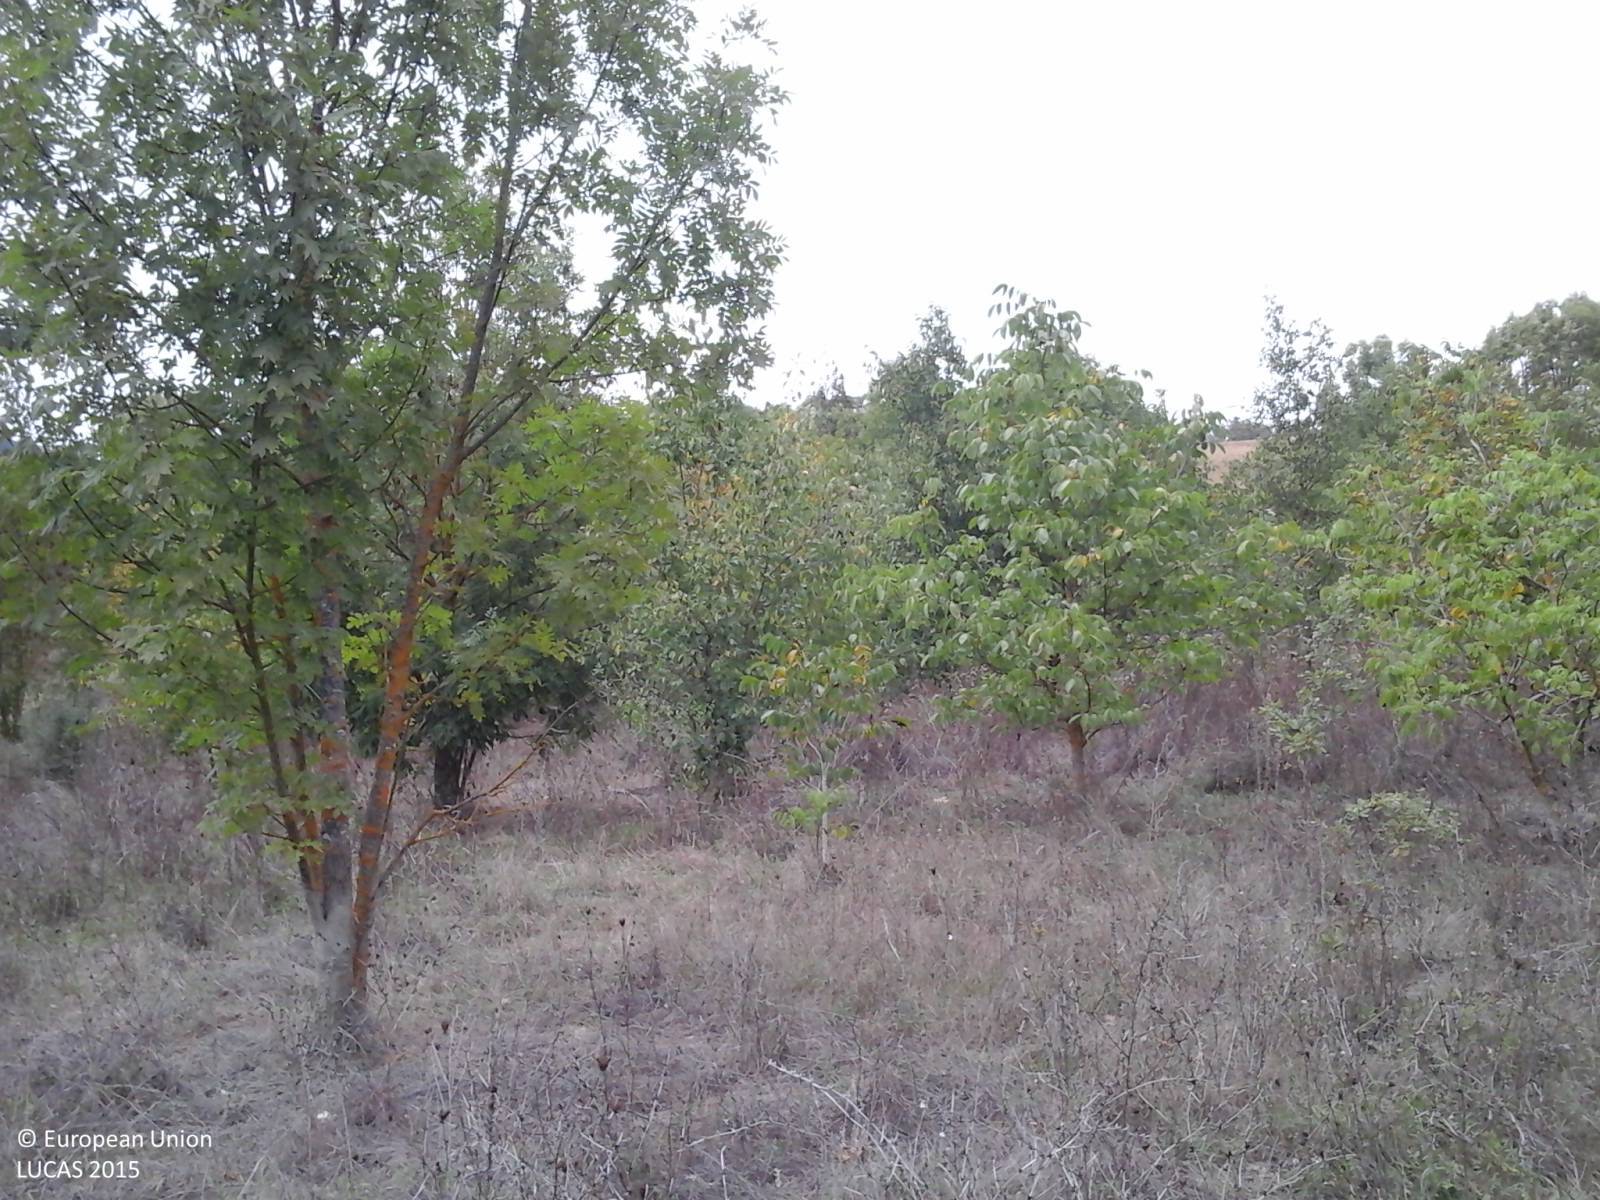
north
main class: Woodland
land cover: Broadleaved woodland
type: thermophilous deciduous forest
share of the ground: > 75 %
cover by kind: broadleaved forest trees 60 %, shrubs 40 %
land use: Forestry
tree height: > 5 m
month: September
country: IT
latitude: 42.9540
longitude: 12.2608
